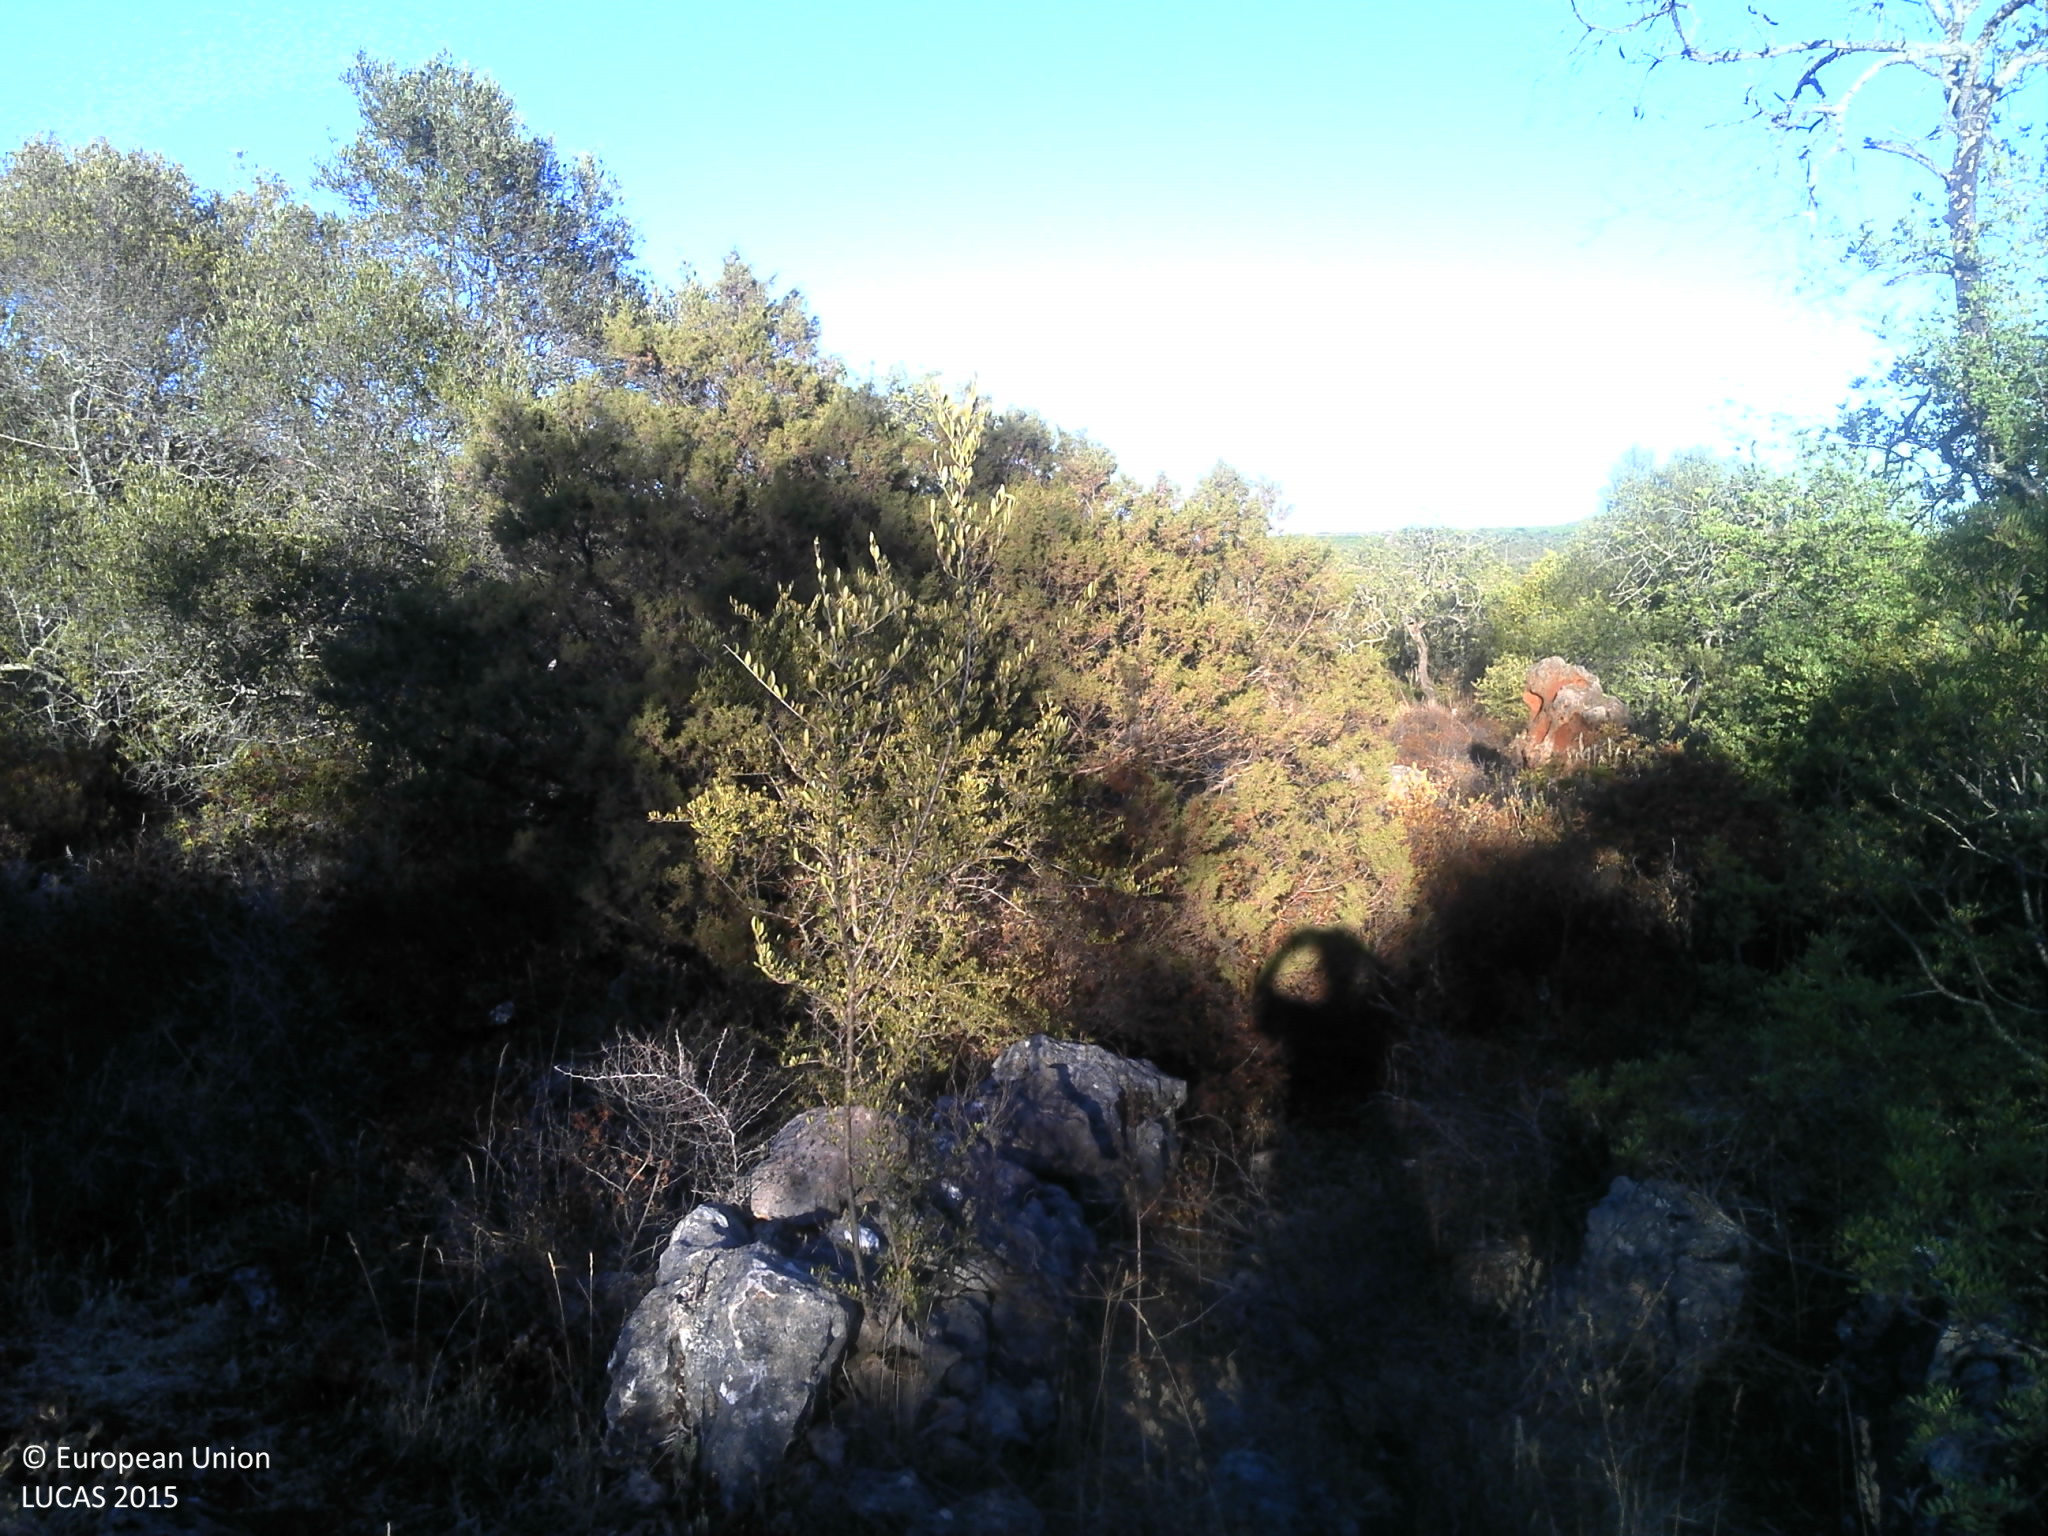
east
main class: Shrubland
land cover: Shrubland with sparse tree cover
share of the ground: 50 - 75 %
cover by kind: shrubs 50 %, unconsolidated bare surface 40 %, broadleaved forest trees 5 %, herbaceous plants 5 %
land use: Abandoned areas
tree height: < 5 m
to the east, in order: Shrubland with sparse tree cover; Dry stone walls; Shrubland with sparse tree cover; Permanent industrial crops; Shrubland with sparse tree cover; Dry stone walls; Shrubland with sparse tree cover; Permanent industrial crops; Rock outcrops; Olive groves; Dry stone walls; Grass margins; Tracks; Permanent industrial crops; Dry stone walls; Olive groves; Shrubland with sparse tree cover; Fences; Shrubland with sparse tree cover; Fences; Paved roads, cycling and walking lanes; Grass margins; Permanent industrial crops; Grassland with sparse tree/shrub cover; Permanent industrial crops
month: September
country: PT
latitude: 37.2299
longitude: -8.1303
